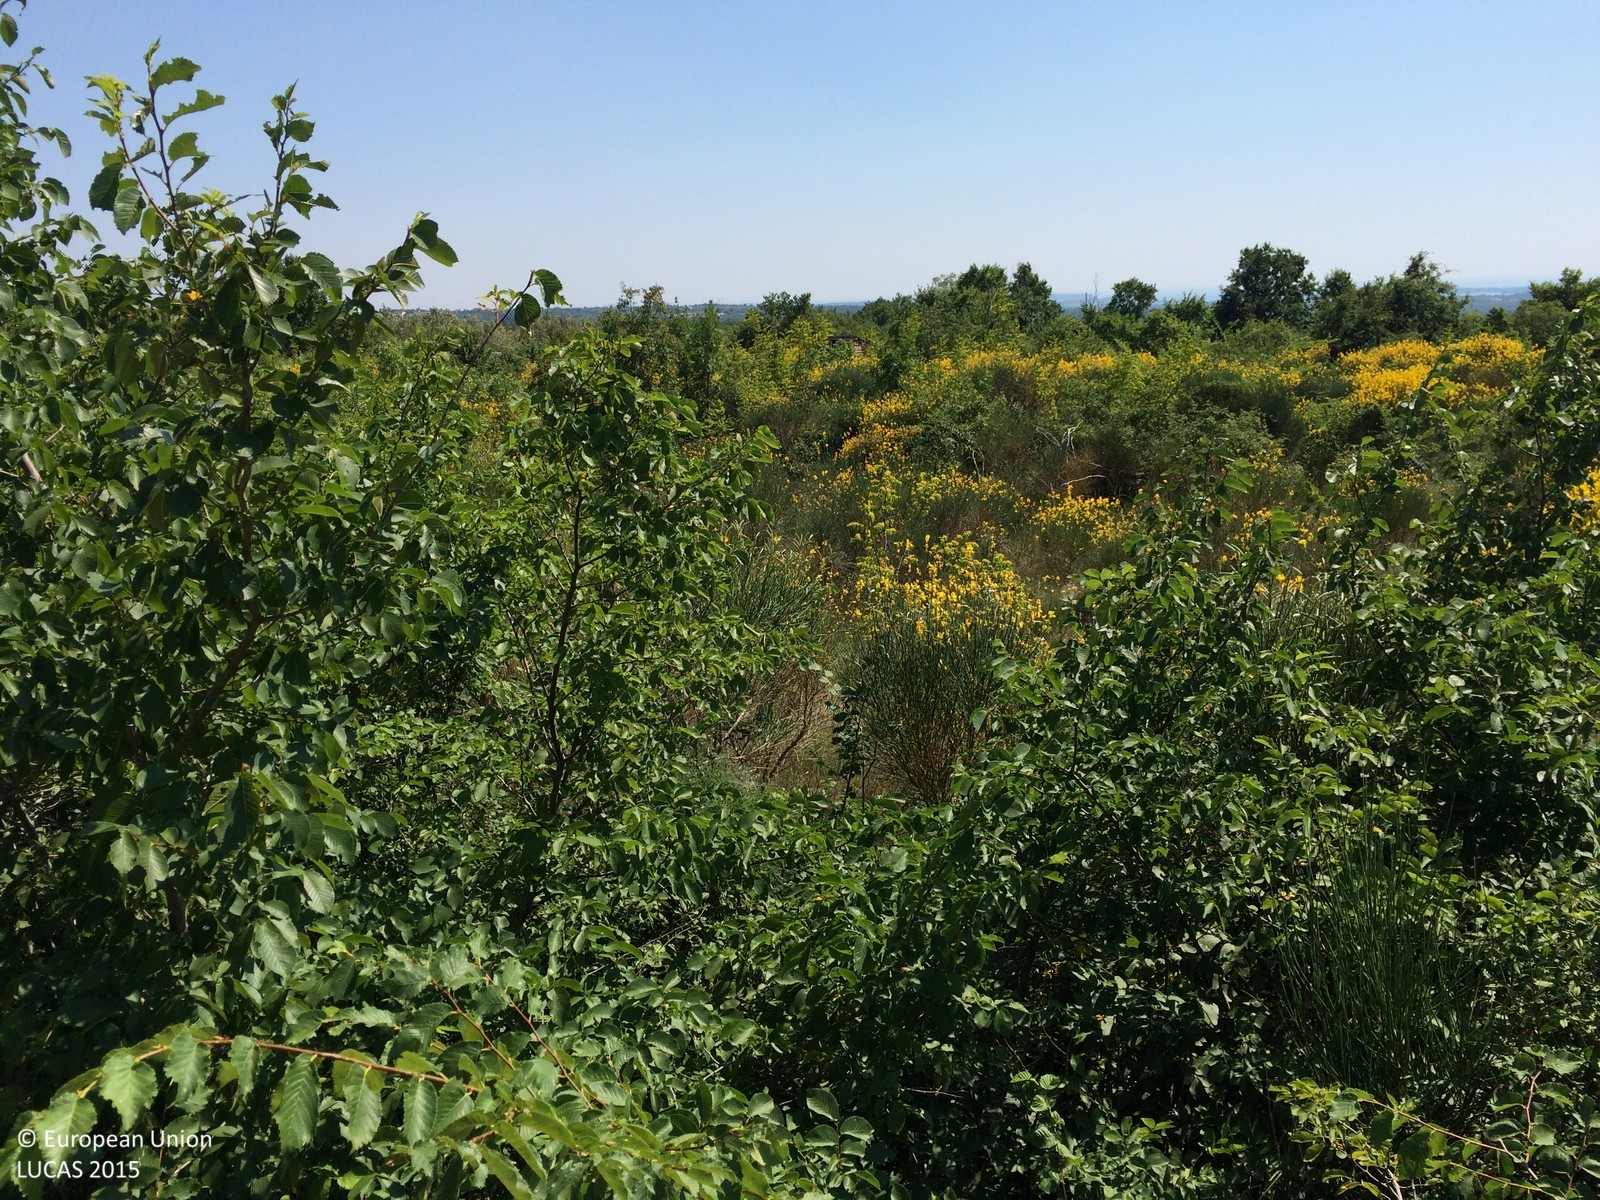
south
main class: Shrubland
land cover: Shrubland with sparse tree cover
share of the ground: > 75 %
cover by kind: shrubs 90 %, broadleaved forest trees 5 %, herbaceous plants 5 %
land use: Semi-natural and natural areas not in use
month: June
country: HR
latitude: 44.9836
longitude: 13.8370
